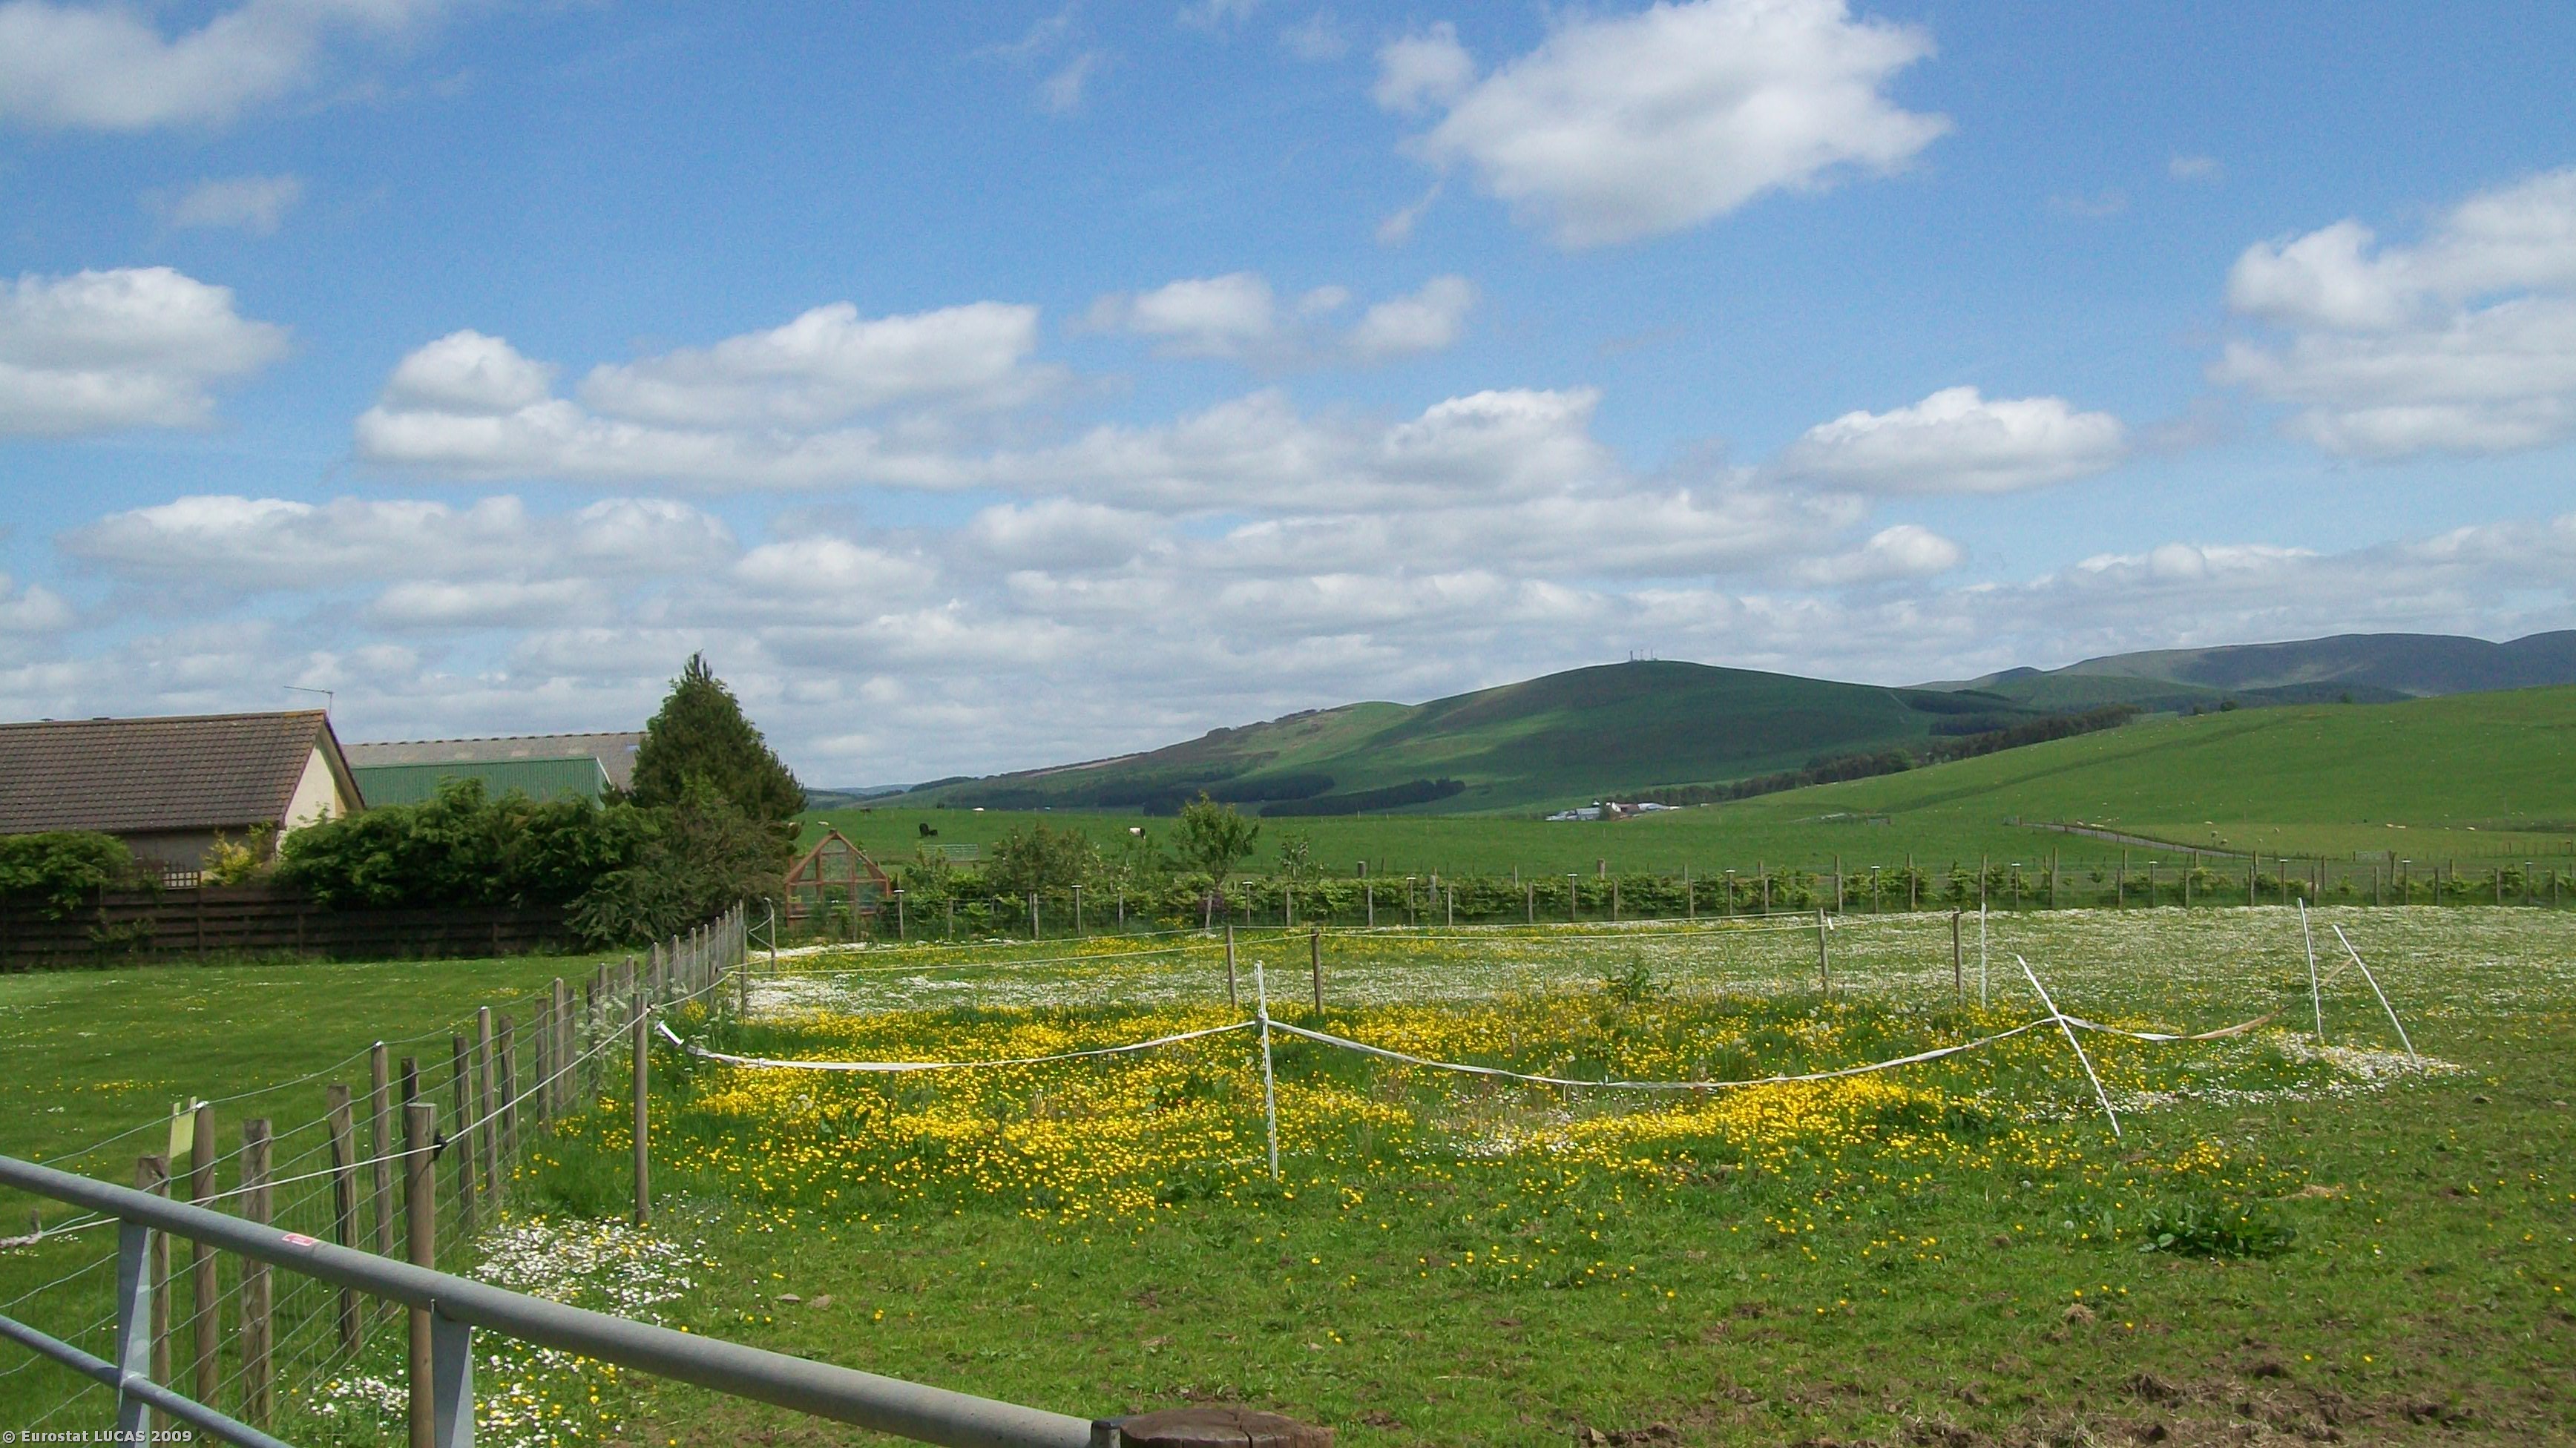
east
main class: Artificial land
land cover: Non built-up area features
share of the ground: > 75 %
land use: Residential
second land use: Agriculture (excluding fallow land and kitchen gardens)
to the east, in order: Grassland with sparse tree/shrub cover; Artificial constructions in urban areas; Fences; Artificial constructions in urban areas; Fences; Grassland without tree/shrub cover; Fences; Barley; Fences; Grassland without tree/shrub cover
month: June
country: GB
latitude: 55.6693
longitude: -3.5134
